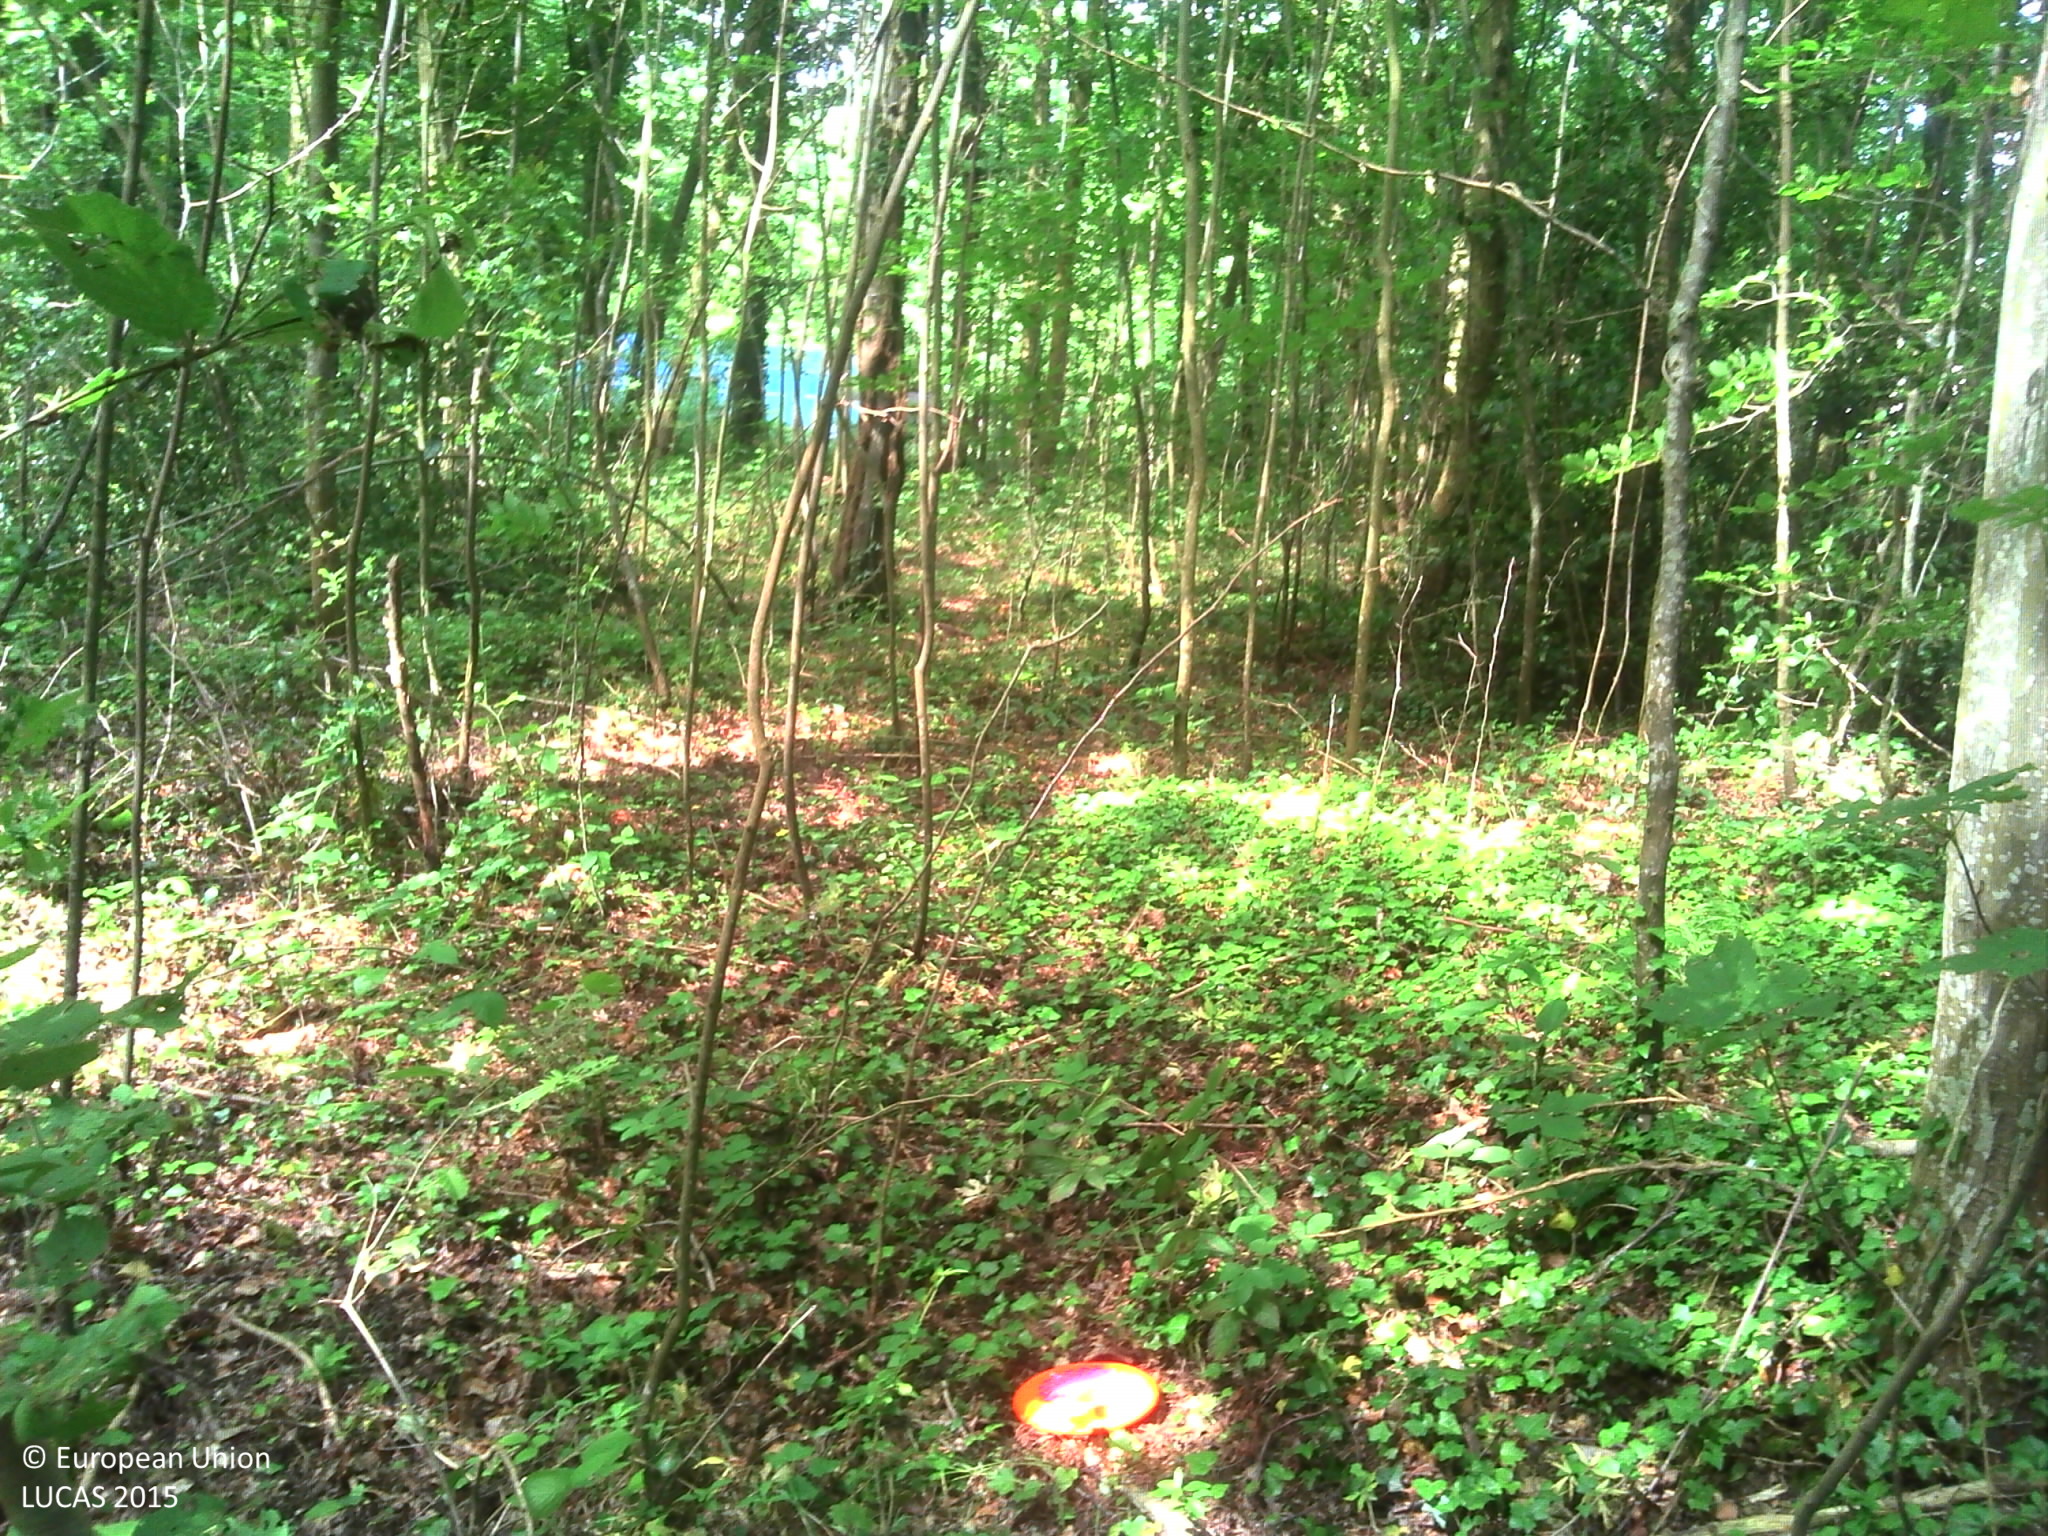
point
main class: Woodland
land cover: Broadleaved woodland
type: mesophytic deciduous forest
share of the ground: > 75 %
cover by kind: broadleaved forest trees 90 %, shrubs 10 %
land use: Forestry
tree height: > 5 m
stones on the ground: < 10 %
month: June
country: FR
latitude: 49.4760
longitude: 2.9101
